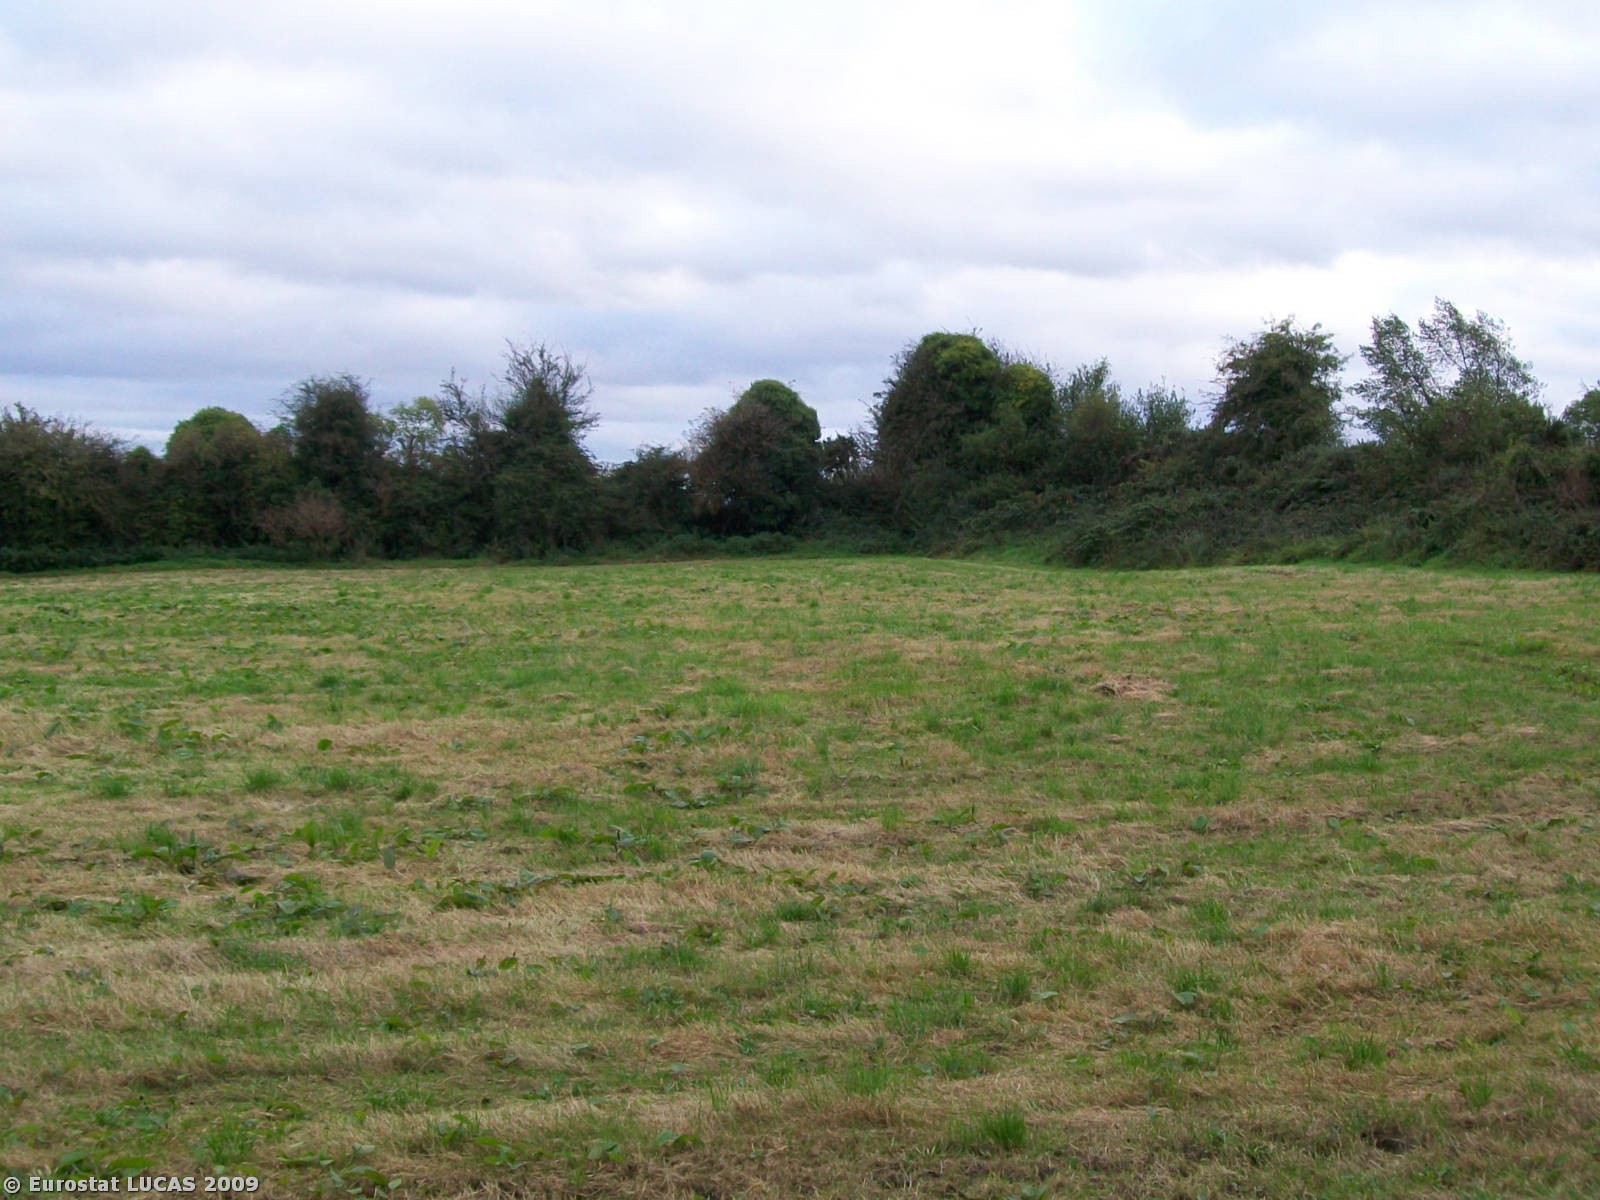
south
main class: Grassland
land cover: Grassland without tree/shrub cover
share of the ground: > 75 %
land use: Agriculture (excluding fallow land and kitchen gardens)
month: September
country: IE
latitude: 53.1447
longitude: -8.3533
